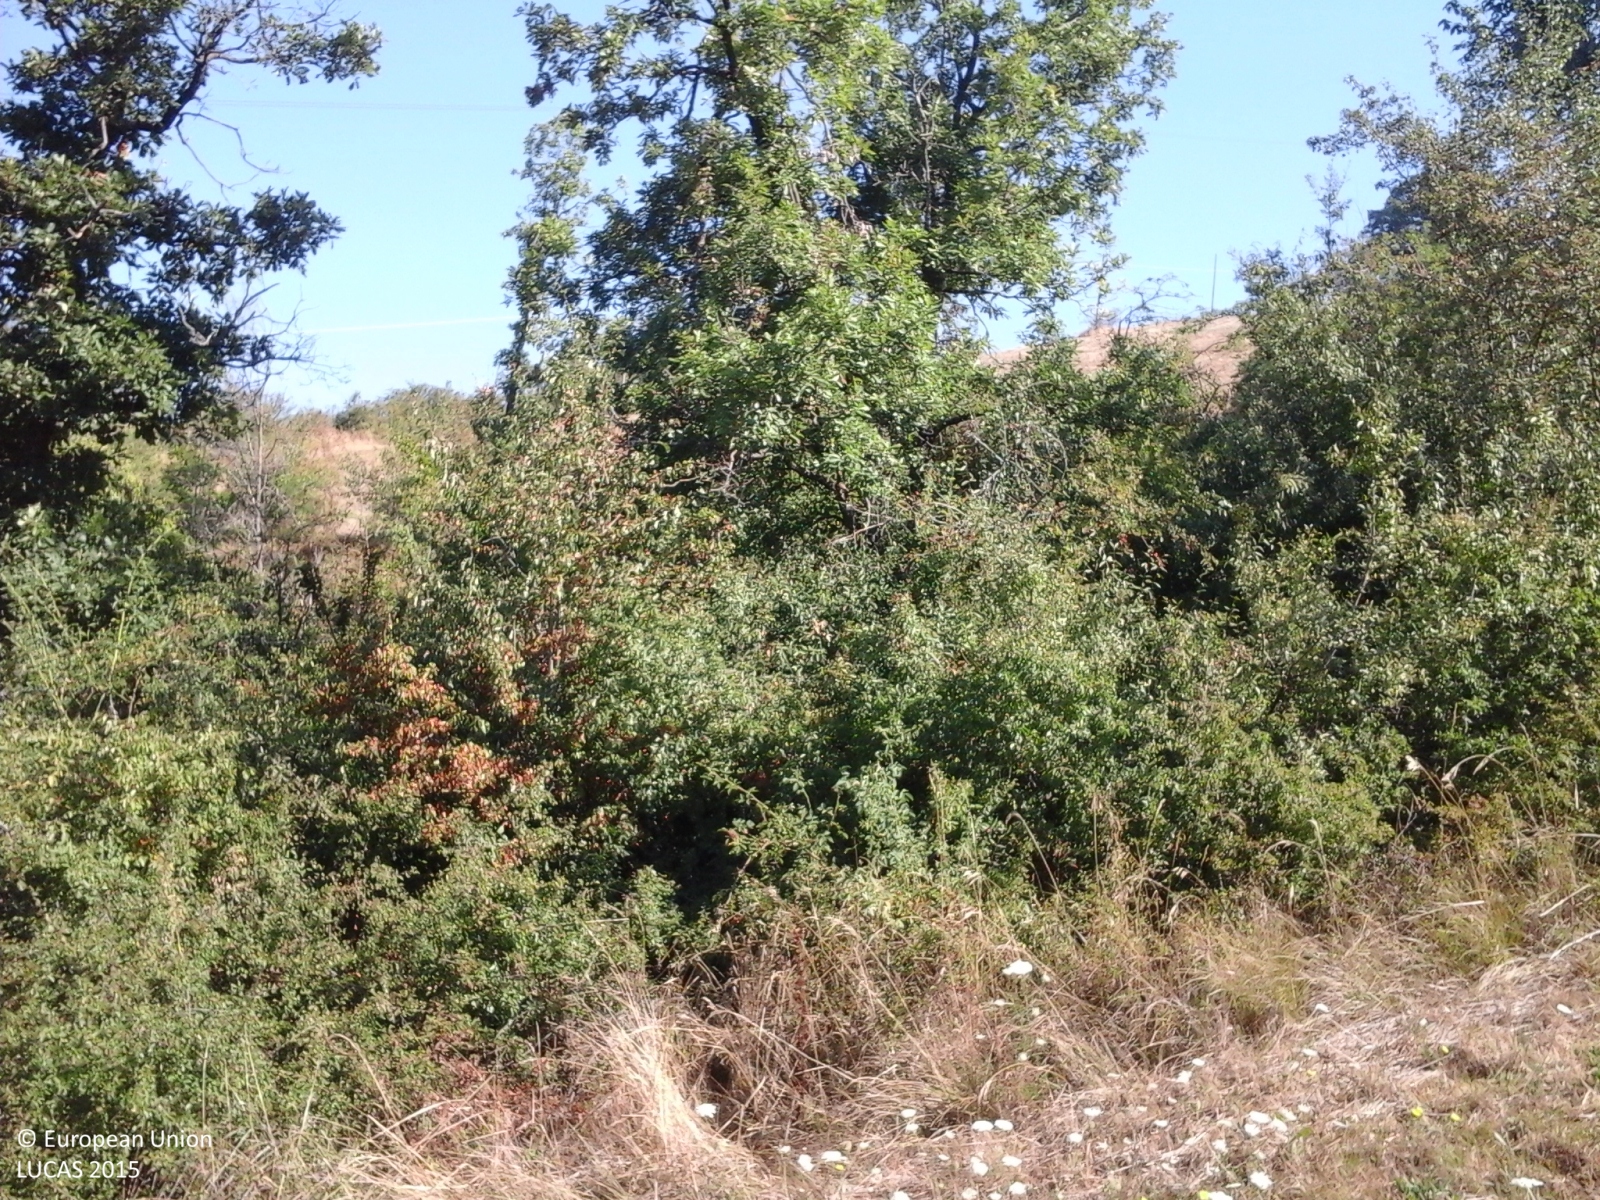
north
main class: Grassland
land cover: Grassland without tree/shrub cover
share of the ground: > 75 %
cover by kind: herbaceous plants 100 %
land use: Semi-natural and natural areas not in use
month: May
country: IT
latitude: 44.3658
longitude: 10.7637
